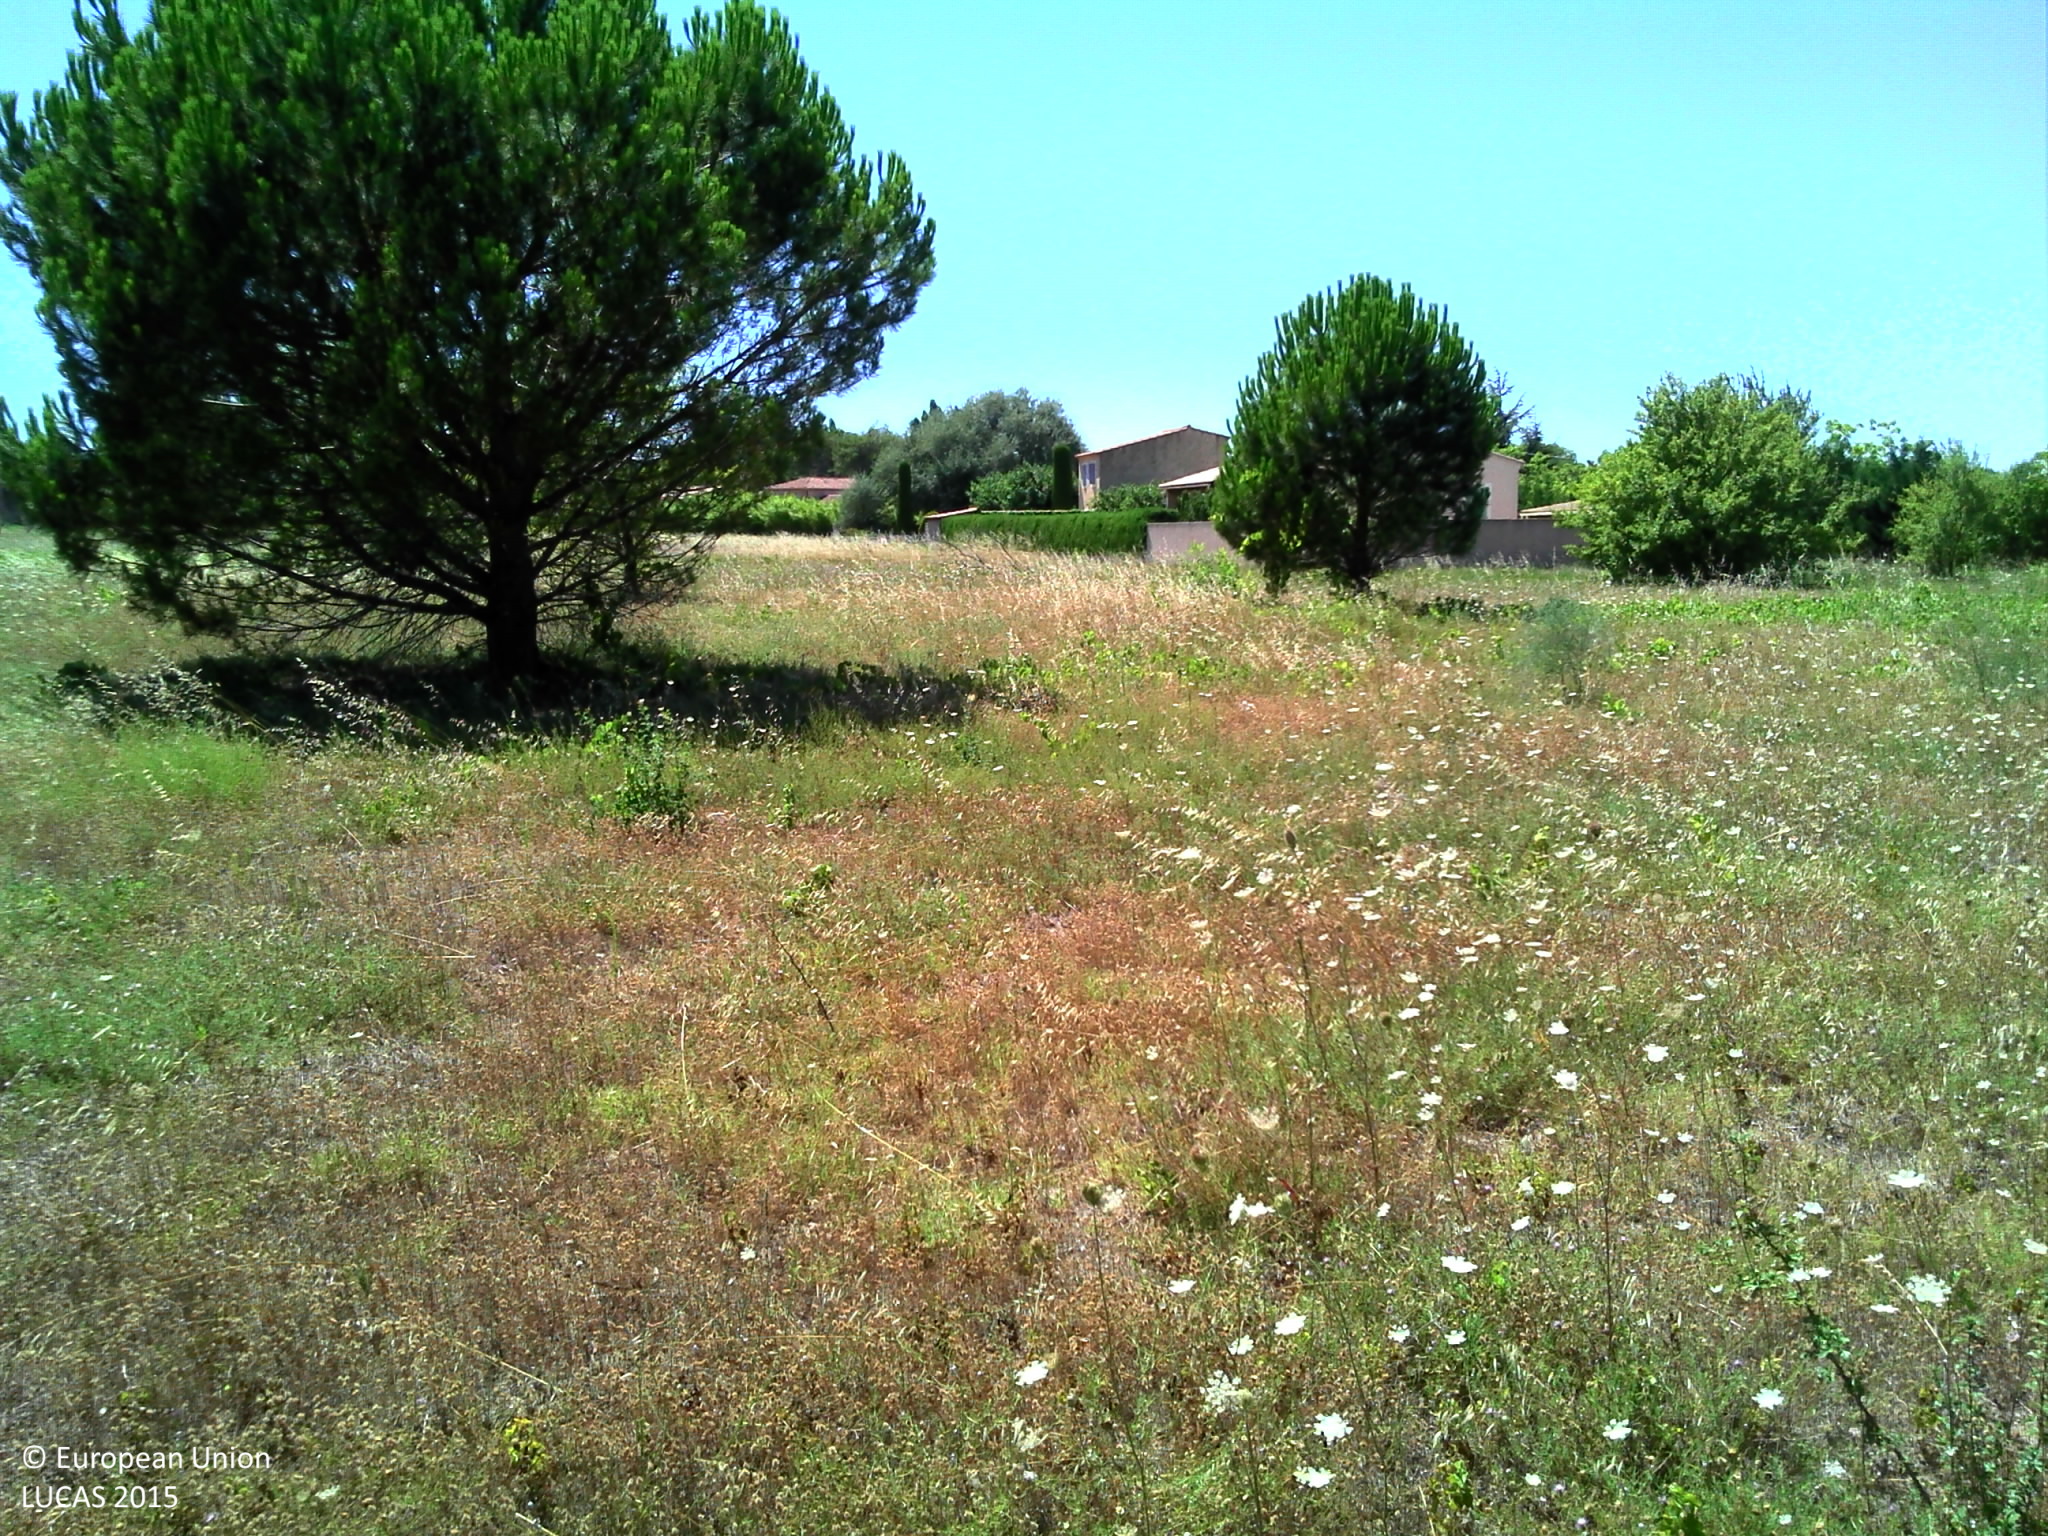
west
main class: Grassland
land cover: Grassland with sparse tree/shrub cover
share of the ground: > 75 %
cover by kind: herbaceous plants 90 %, broadleaved forest trees 5 %, shrubs 5 %
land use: Semi-natural and natural areas not in use
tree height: < 5 m
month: July
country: FR
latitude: 43.8563
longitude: 5.1196
